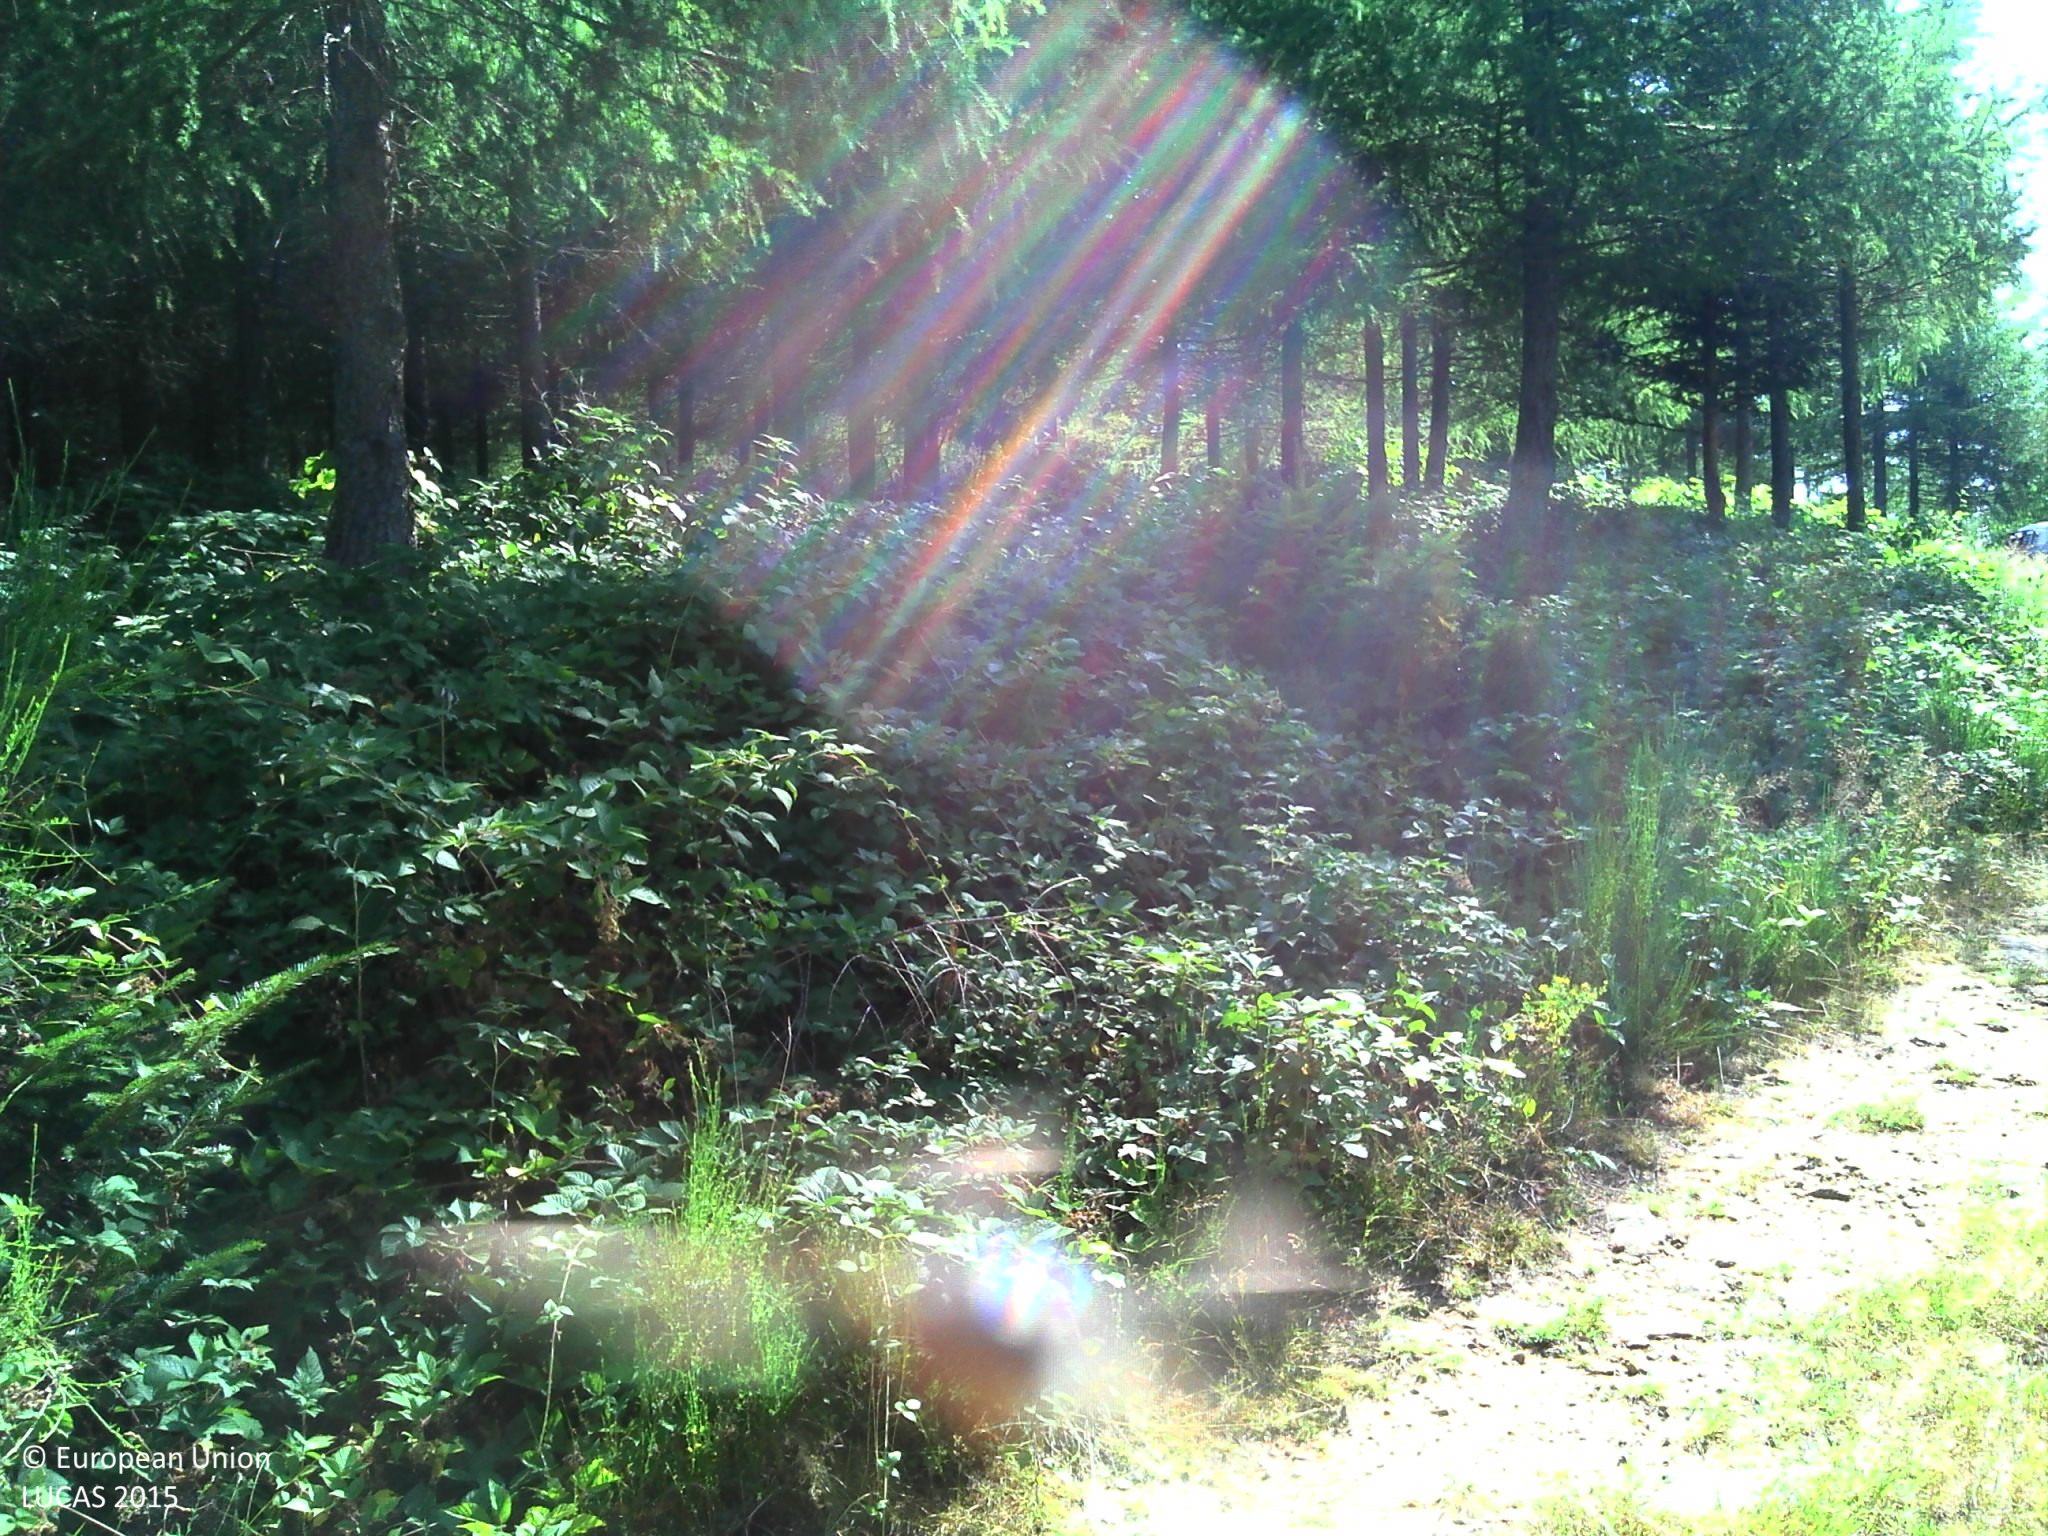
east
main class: Woodland
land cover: Other coniferous woodland
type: exotic forest
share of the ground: > 75 %
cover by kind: coniferous forest trees 65 %, herbaceous plants 25 %, shrubs 10 %
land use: Forestry
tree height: > 5 m
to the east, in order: Other coniferous woodland; Tracks; Other coniferous woodland; Tracks; Spruce dominated coniferous woodland
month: August
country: FR
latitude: 45.3651
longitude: 4.5782
